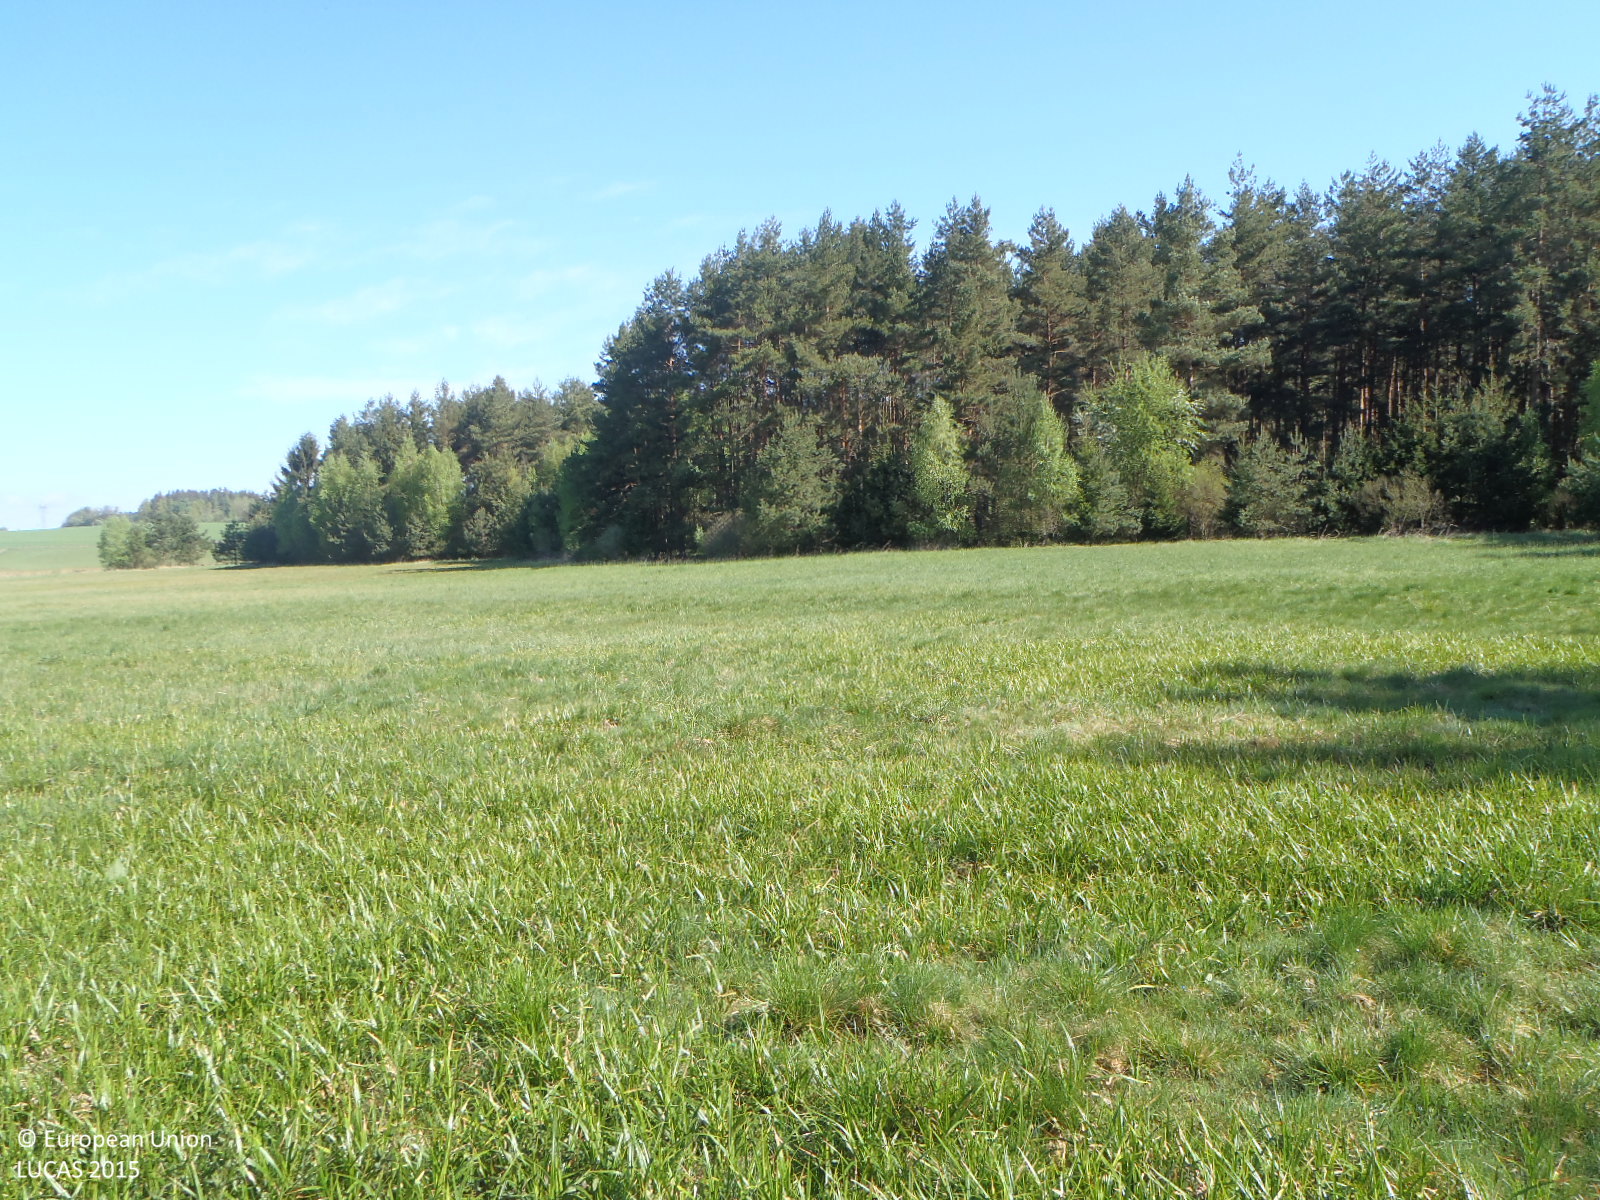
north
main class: Grassland
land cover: Grassland without tree/shrub cover
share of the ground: > 75 %
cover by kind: herbaceous plants 100 %
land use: Agriculture (excluding fallow land and kitchen gardens)
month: May
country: CZ
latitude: 49.0990
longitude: 15.0562
